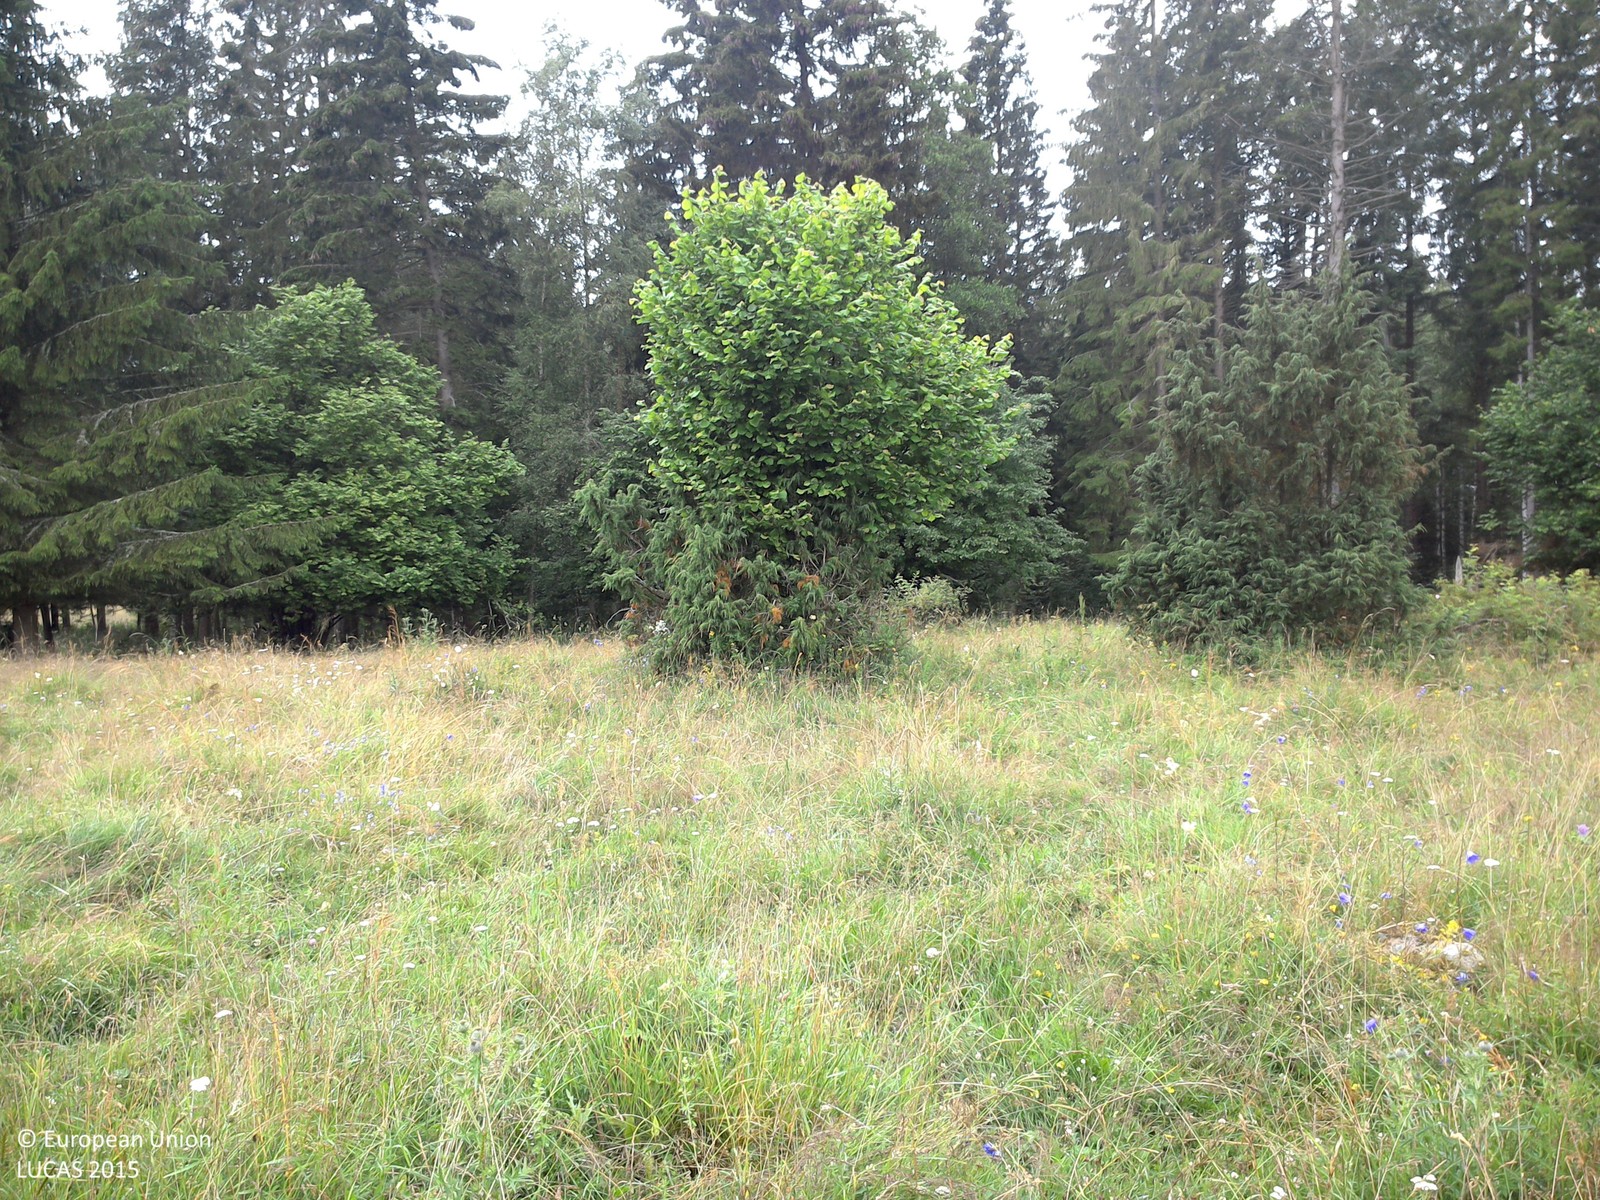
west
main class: Grassland
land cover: Grassland without tree/shrub cover
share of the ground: > 75 %
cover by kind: herbaceous plants 100 %
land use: Agriculture (excluding fallow land and kitchen gardens)
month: July
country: SE
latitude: 58.2903
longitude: 14.9580
